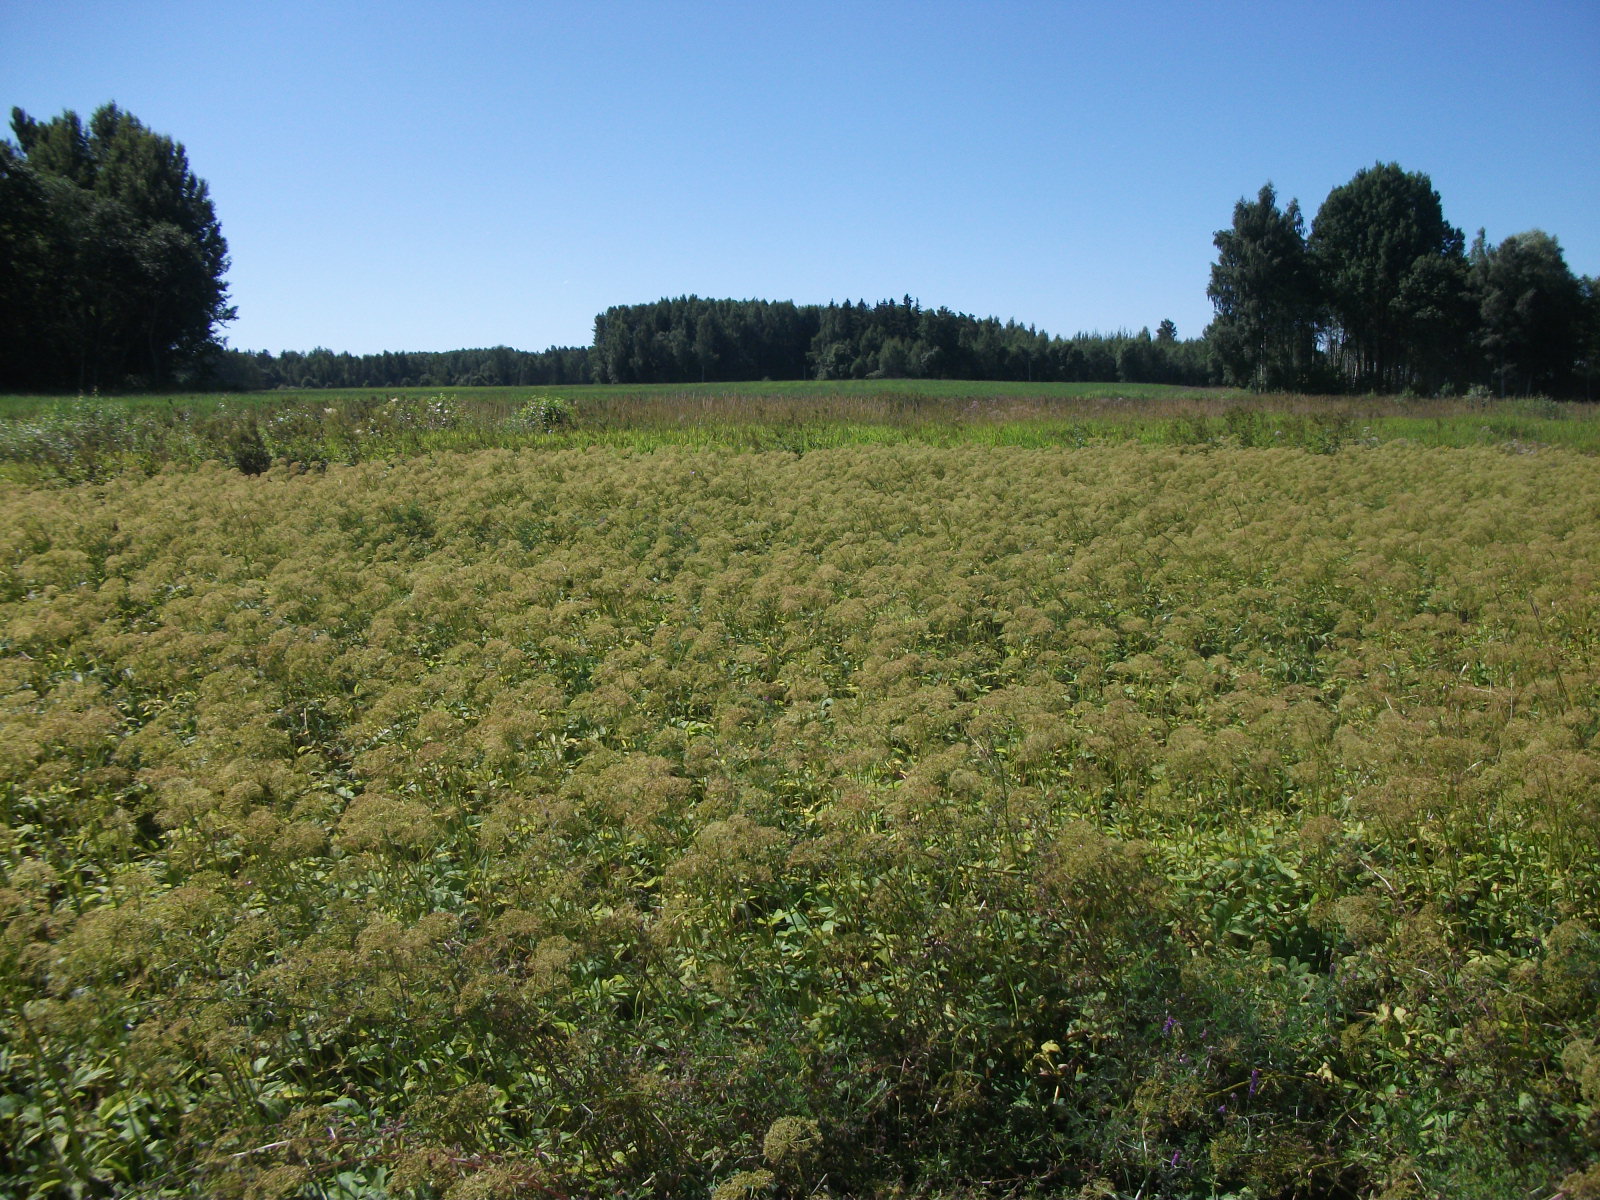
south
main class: Grassland
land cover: Spontaneously vegetated surfaces
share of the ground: > 75 %
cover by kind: herbaceous plants 100 %
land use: Abandoned areas
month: August
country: LV
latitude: 57.0265
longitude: 26.4705
